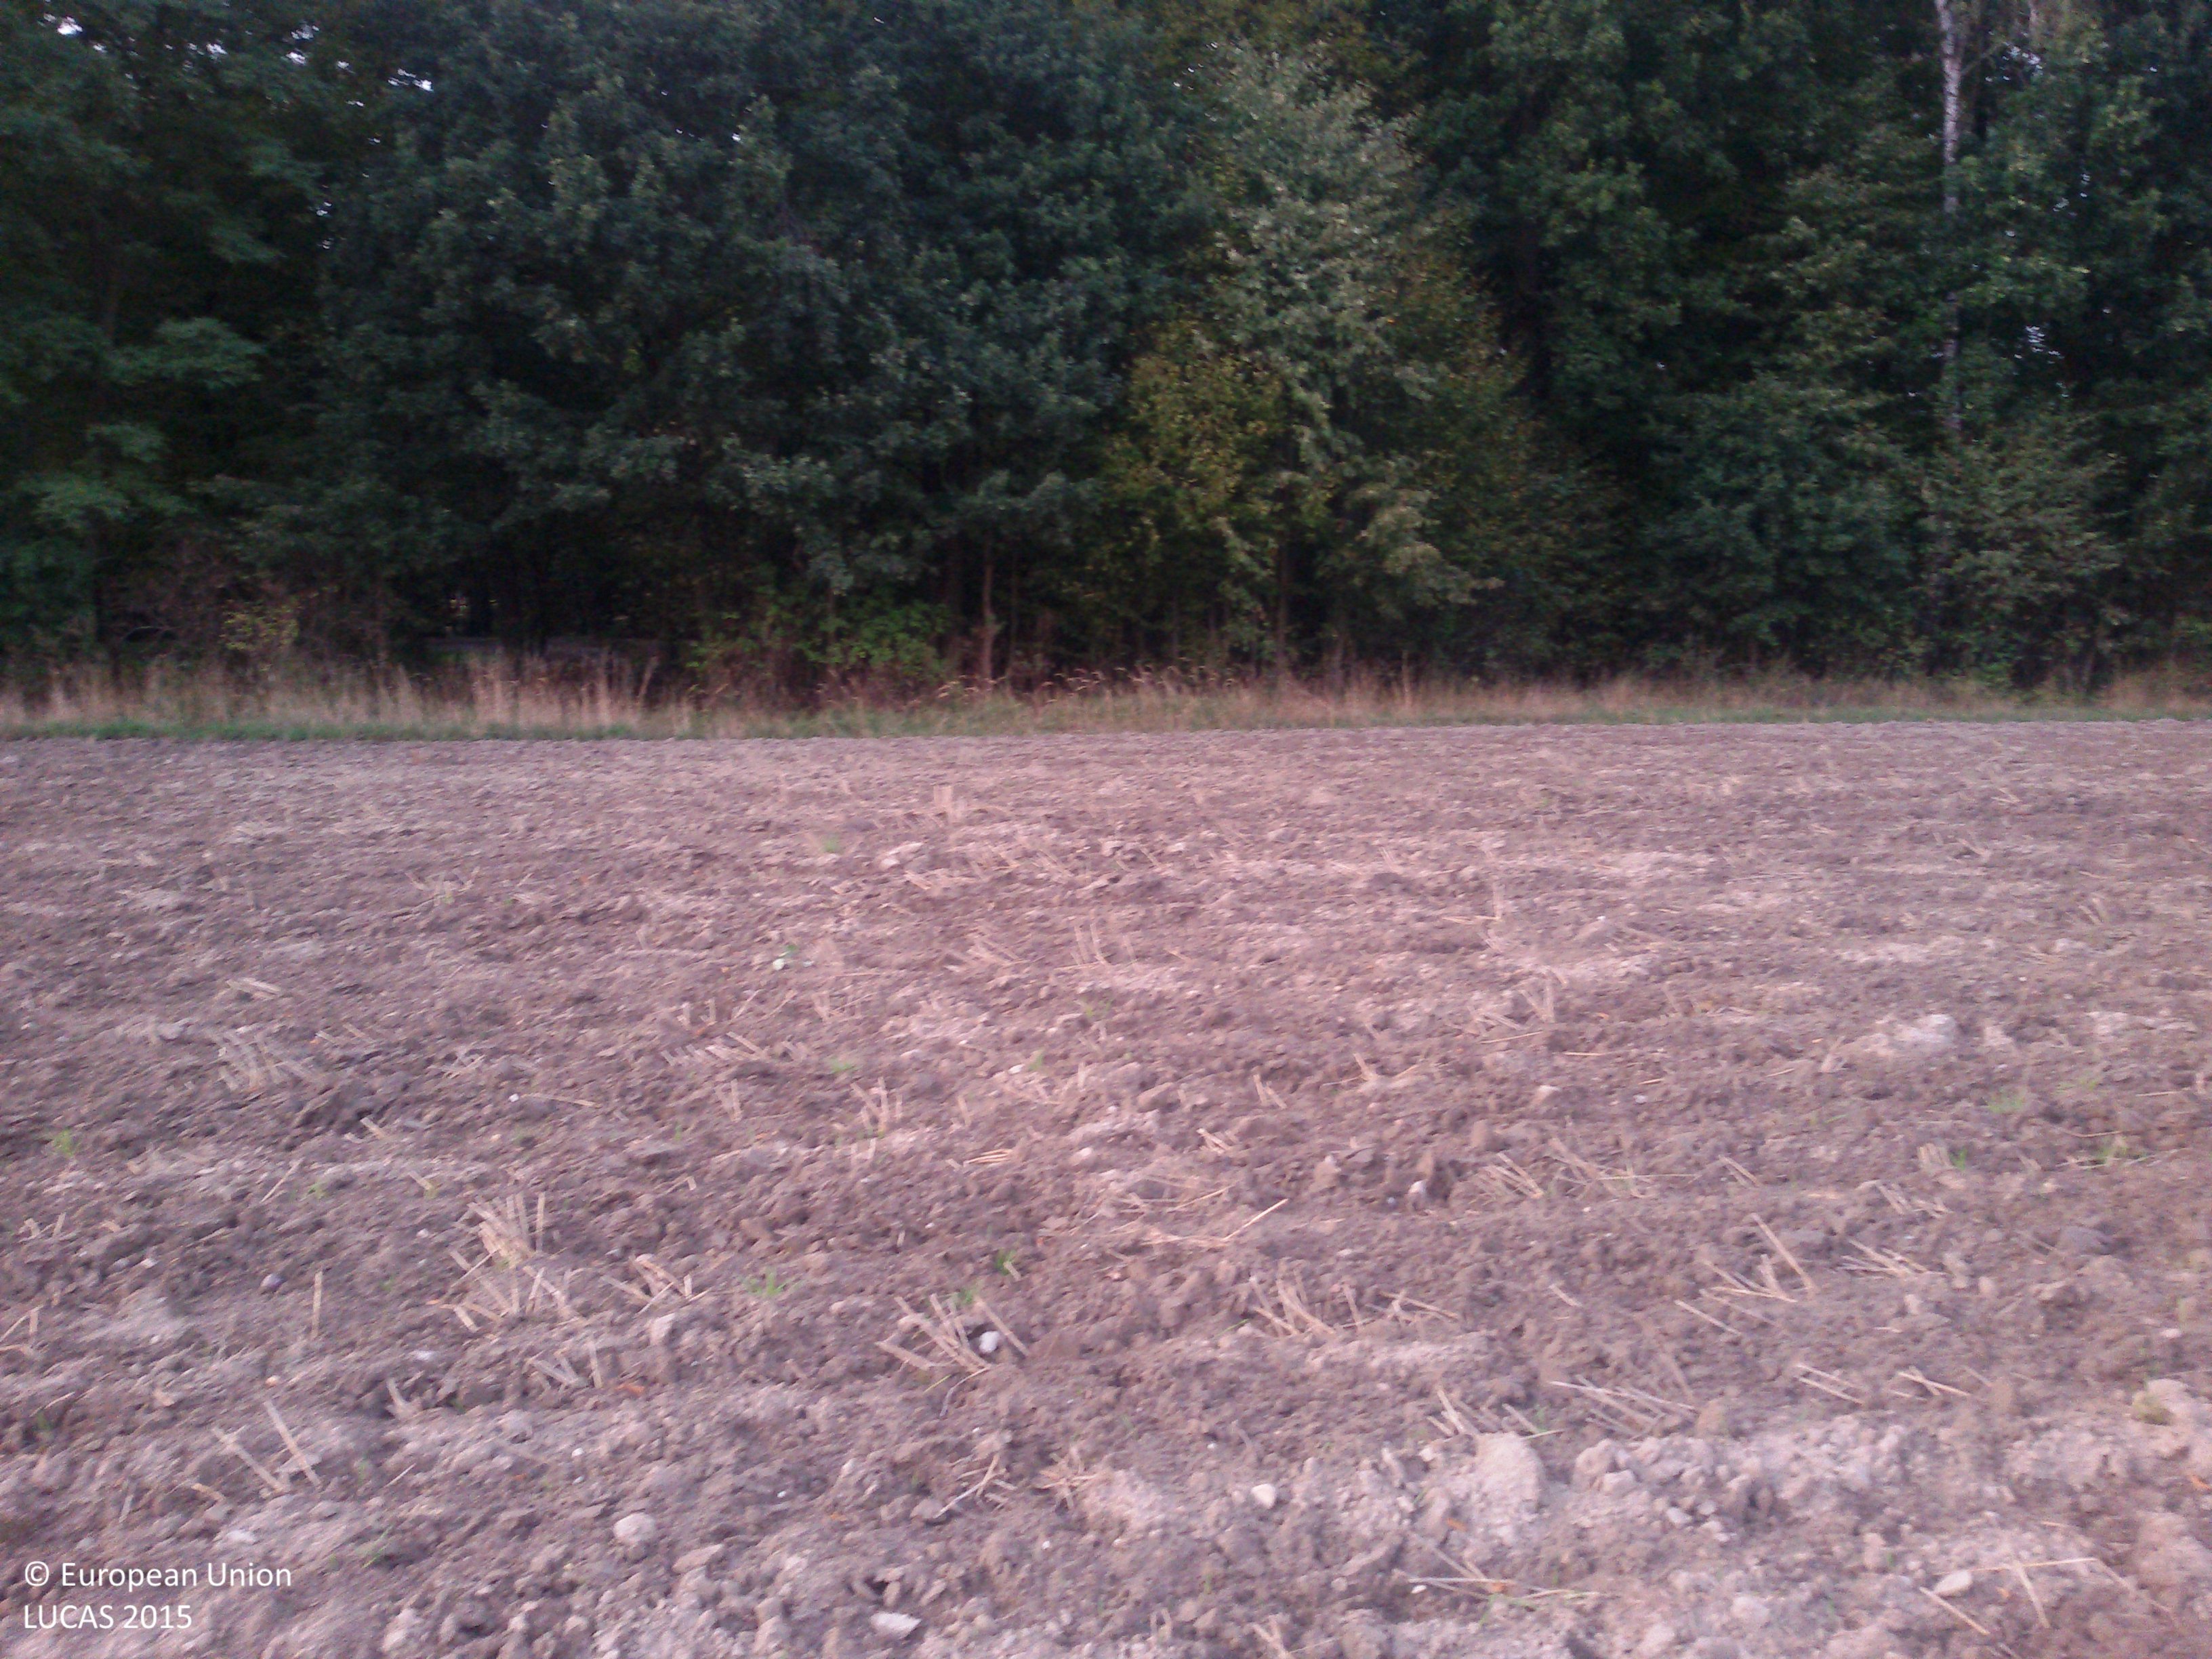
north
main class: Cropland
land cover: Triticale
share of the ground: < 10 %
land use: Agriculture (excluding fallow land and kitchen gardens)
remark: Harvested field
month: September
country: PL
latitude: 50.6813
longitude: 18.7249
